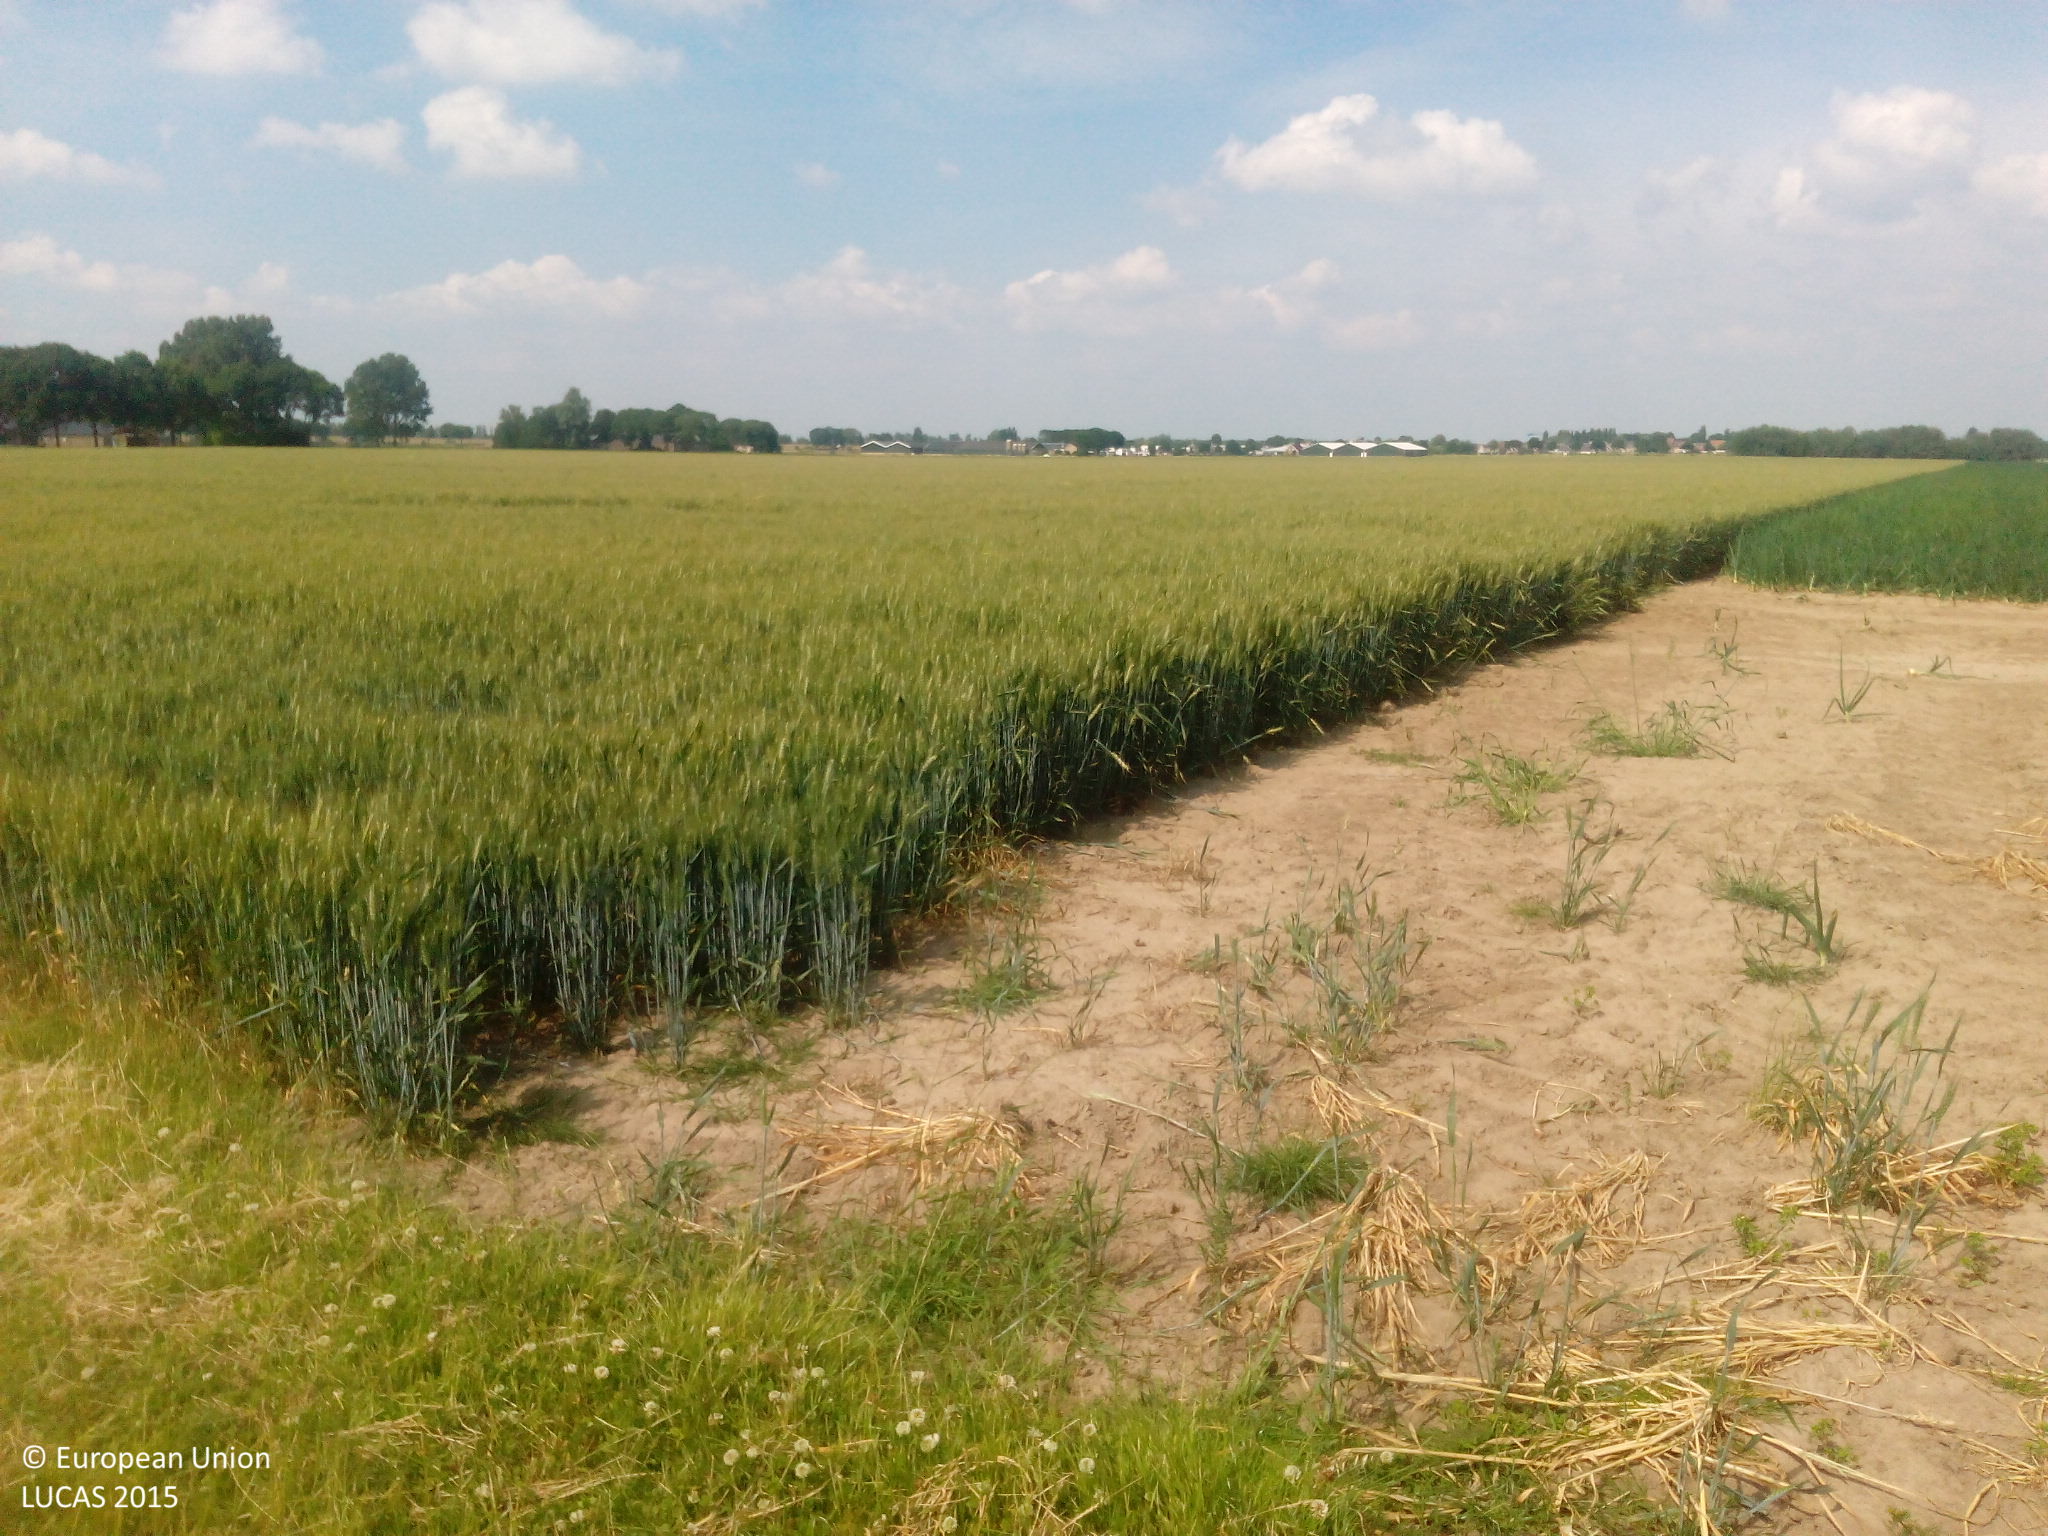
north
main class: Grassland
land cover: Grassland without tree/shrub cover
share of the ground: > 75 %
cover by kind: herbaceous plants 90 %, consolidated bare surface 10 %
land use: Agriculture (excluding fallow land and kitchen gardens)
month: June
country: NL
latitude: 51.7001
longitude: 4.6862
